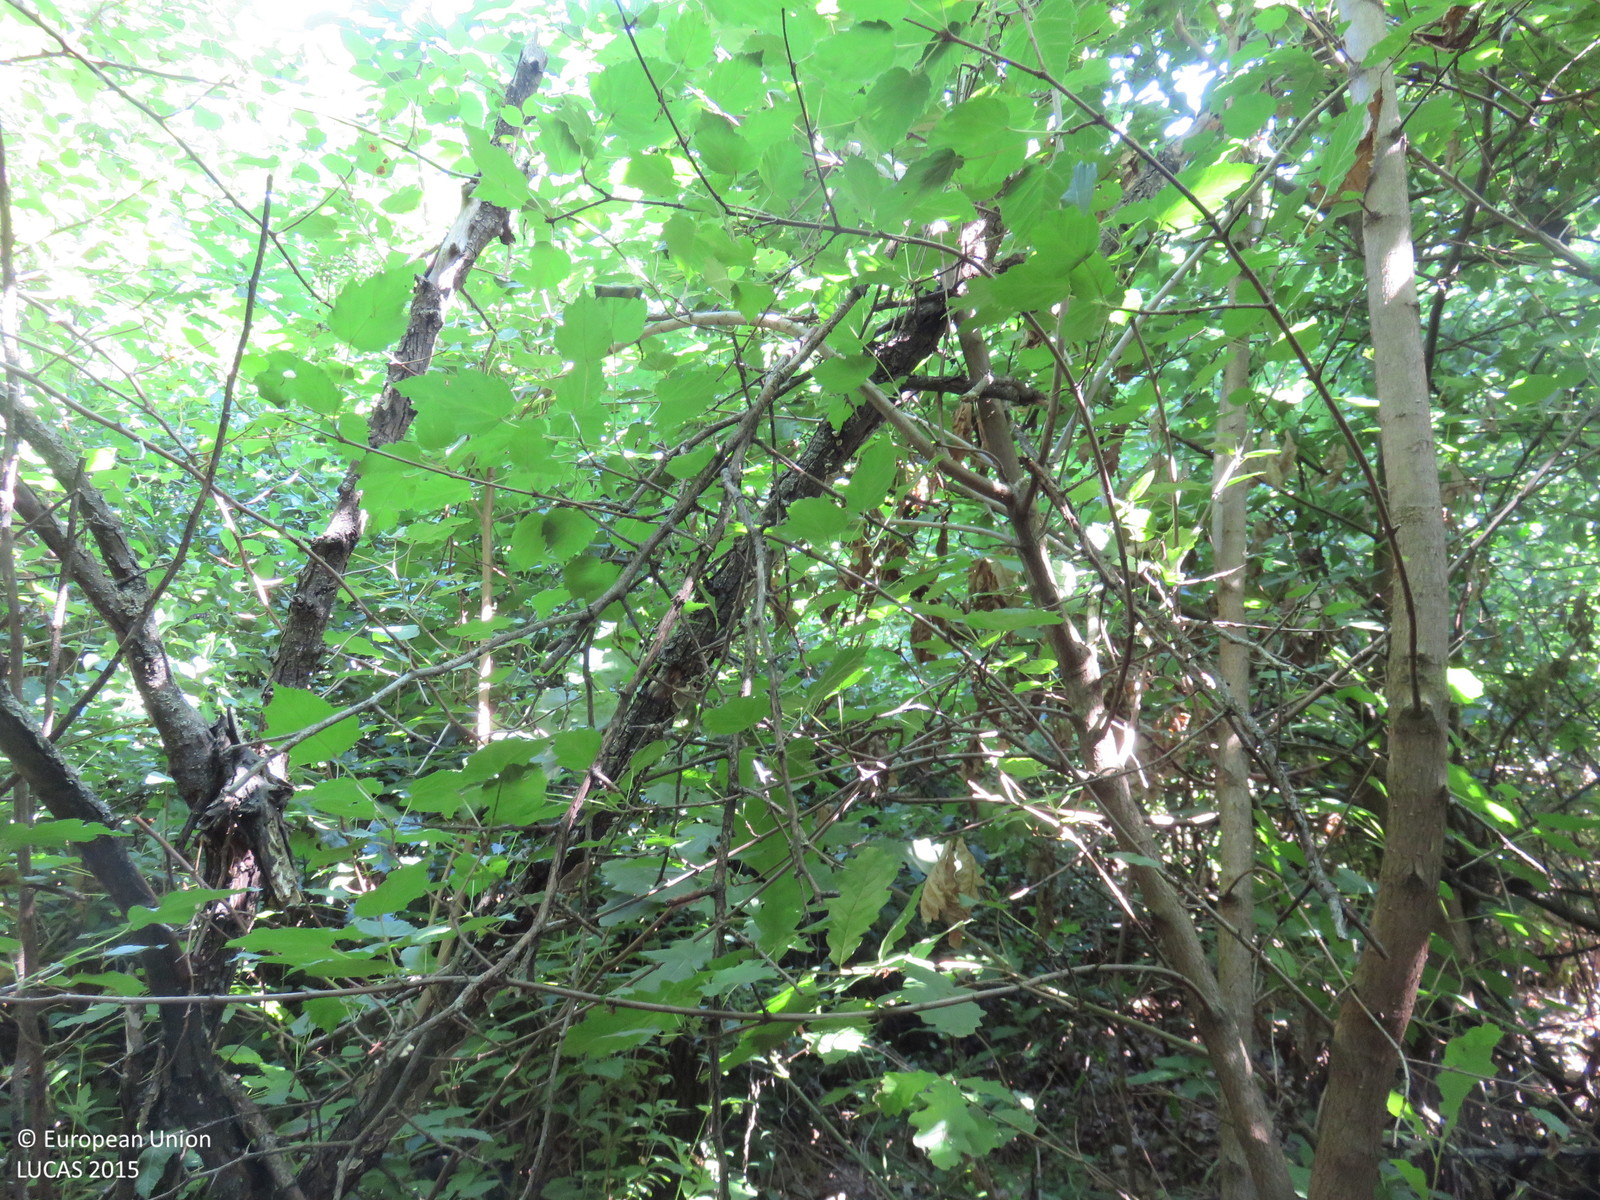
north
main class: Woodland
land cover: Broadleaved woodland
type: mesophytic deciduous forest
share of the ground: > 75 %
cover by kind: broadleaved forest trees 75 %, shrubs 25 %
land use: Semi-natural and natural areas not in use
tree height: < 5 m
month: June
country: BG
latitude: 43.2376
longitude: 24.8551
